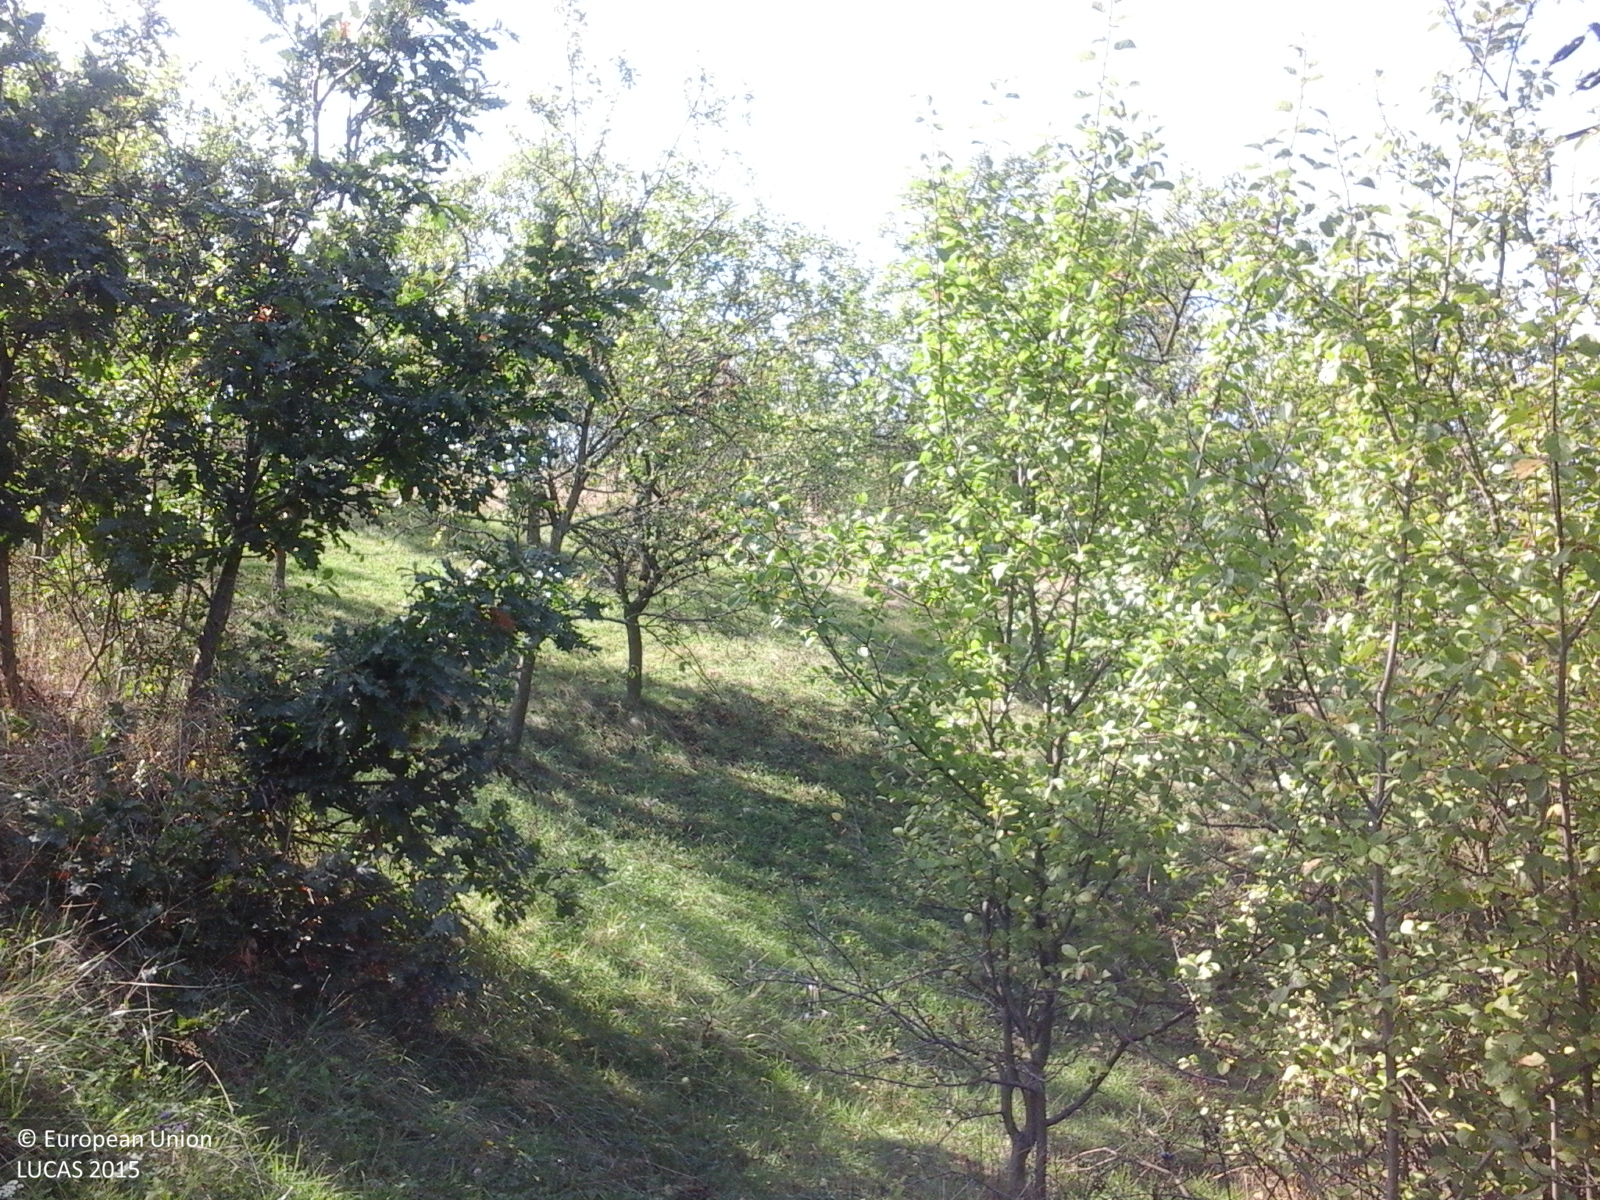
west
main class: Cropland
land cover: Other fruit trees and berries
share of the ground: > 75 %
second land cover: Grassland without tree/shrub cover
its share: > 75 %
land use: Agriculture (excluding fallow land and kitchen gardens)
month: September
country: RO
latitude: 45.6137
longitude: 22.8101
